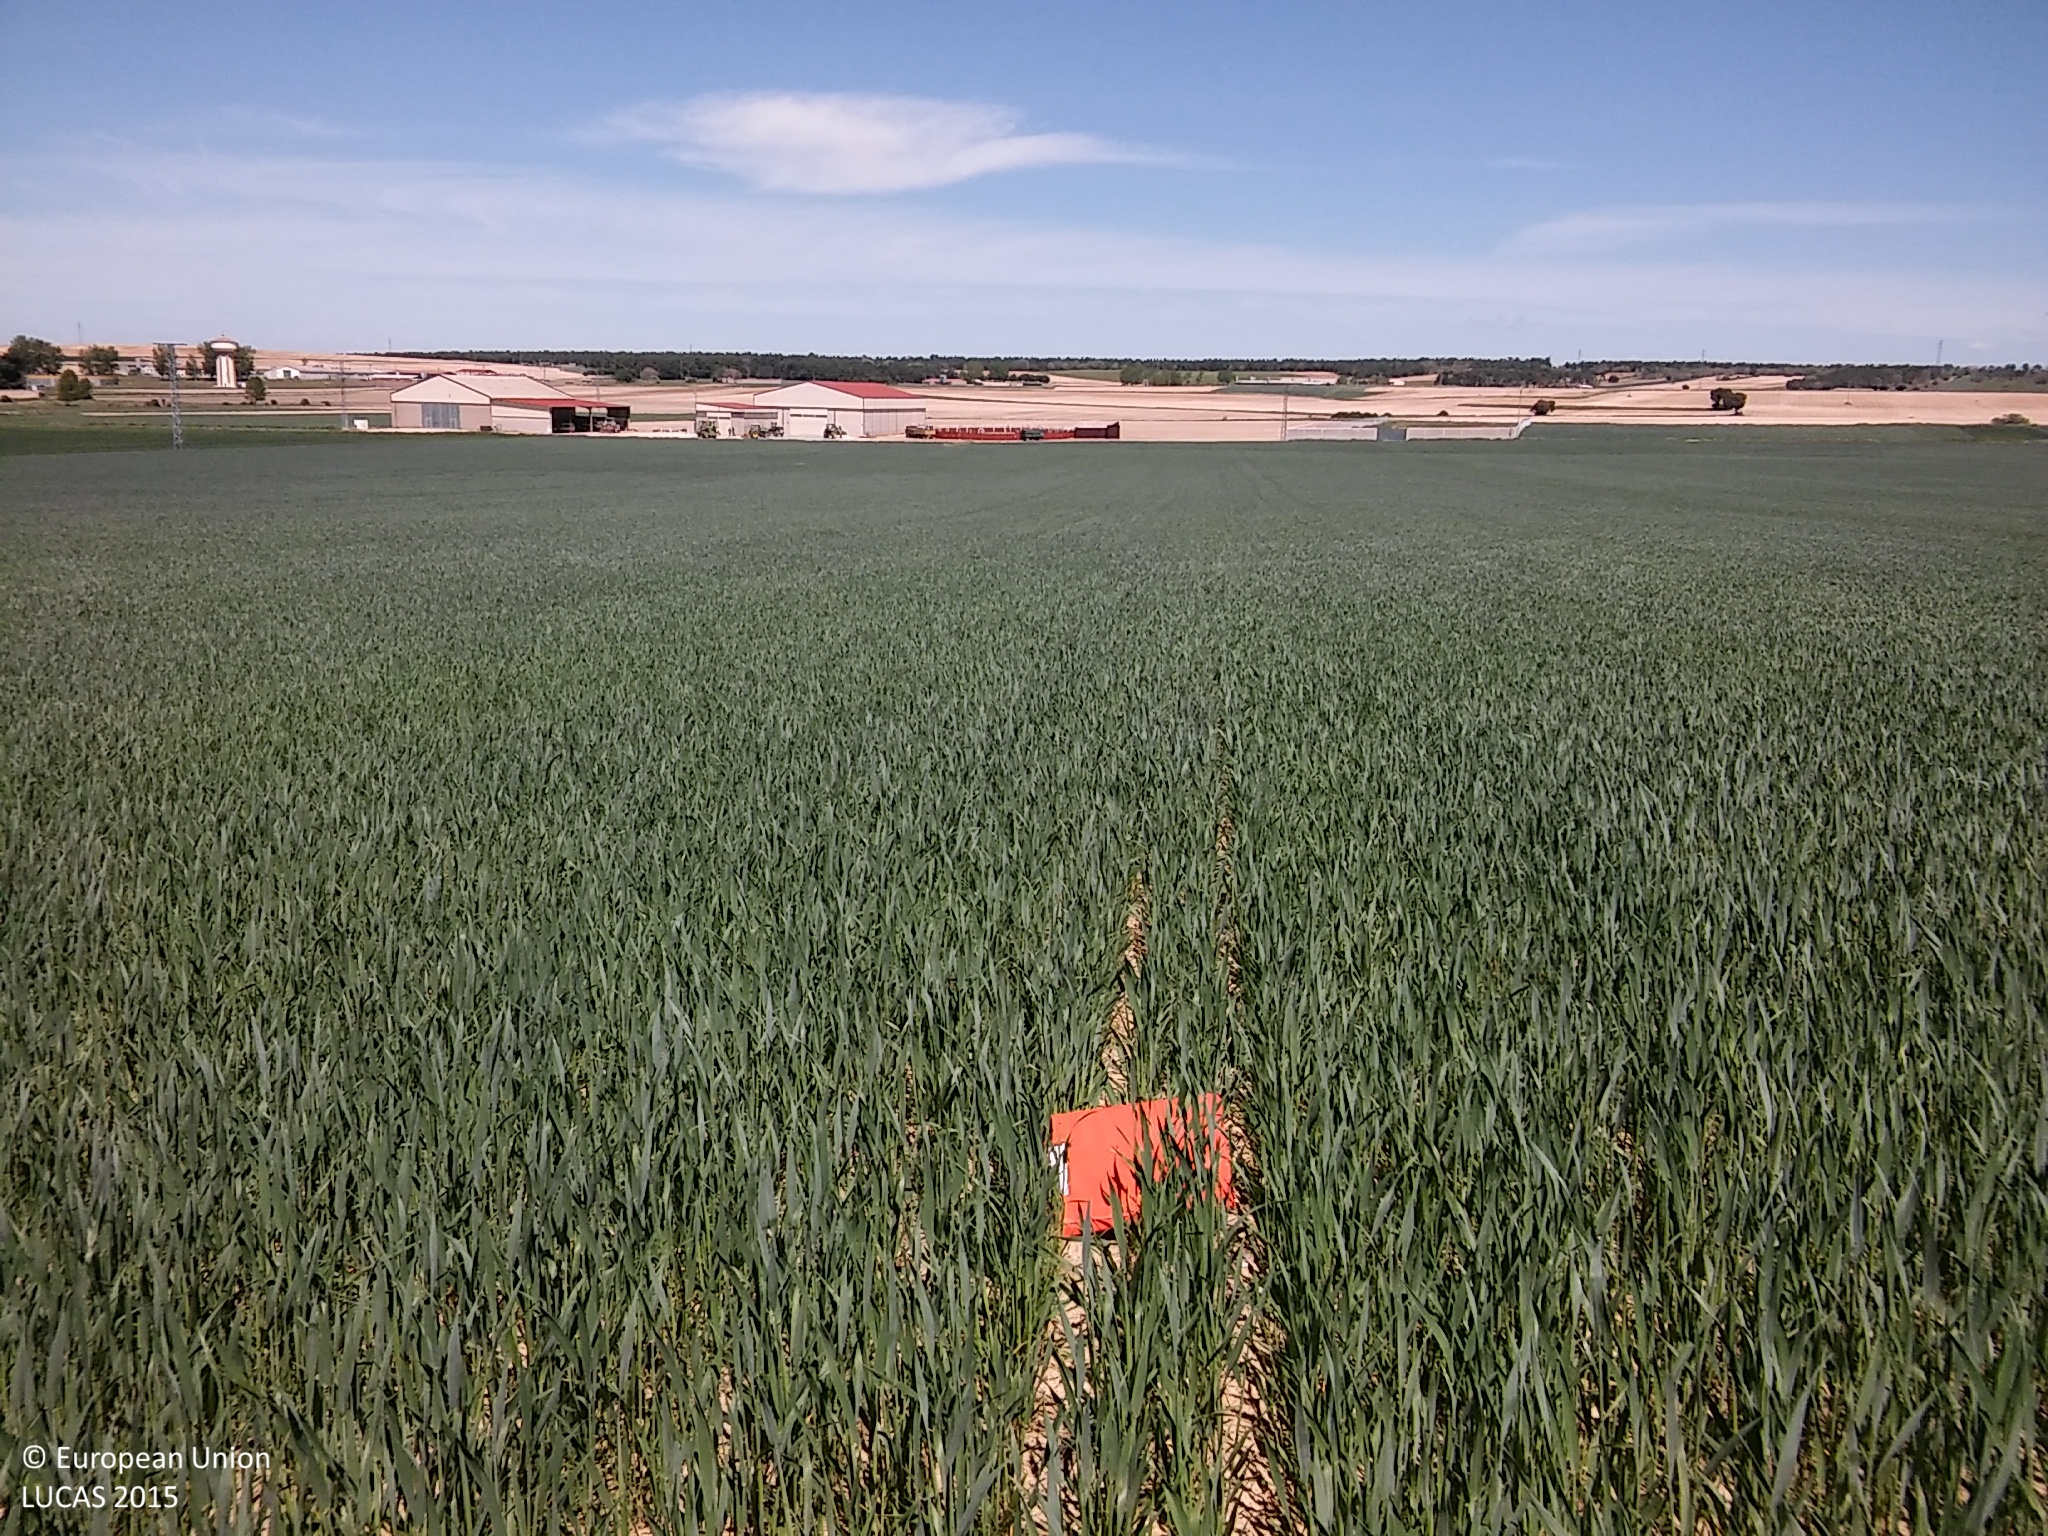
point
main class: Cropland
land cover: Common wheat
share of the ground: > 75 %
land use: Agriculture (excluding fallow land and kitchen gardens)
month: May
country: ES
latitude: 41.2291
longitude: -3.9254
